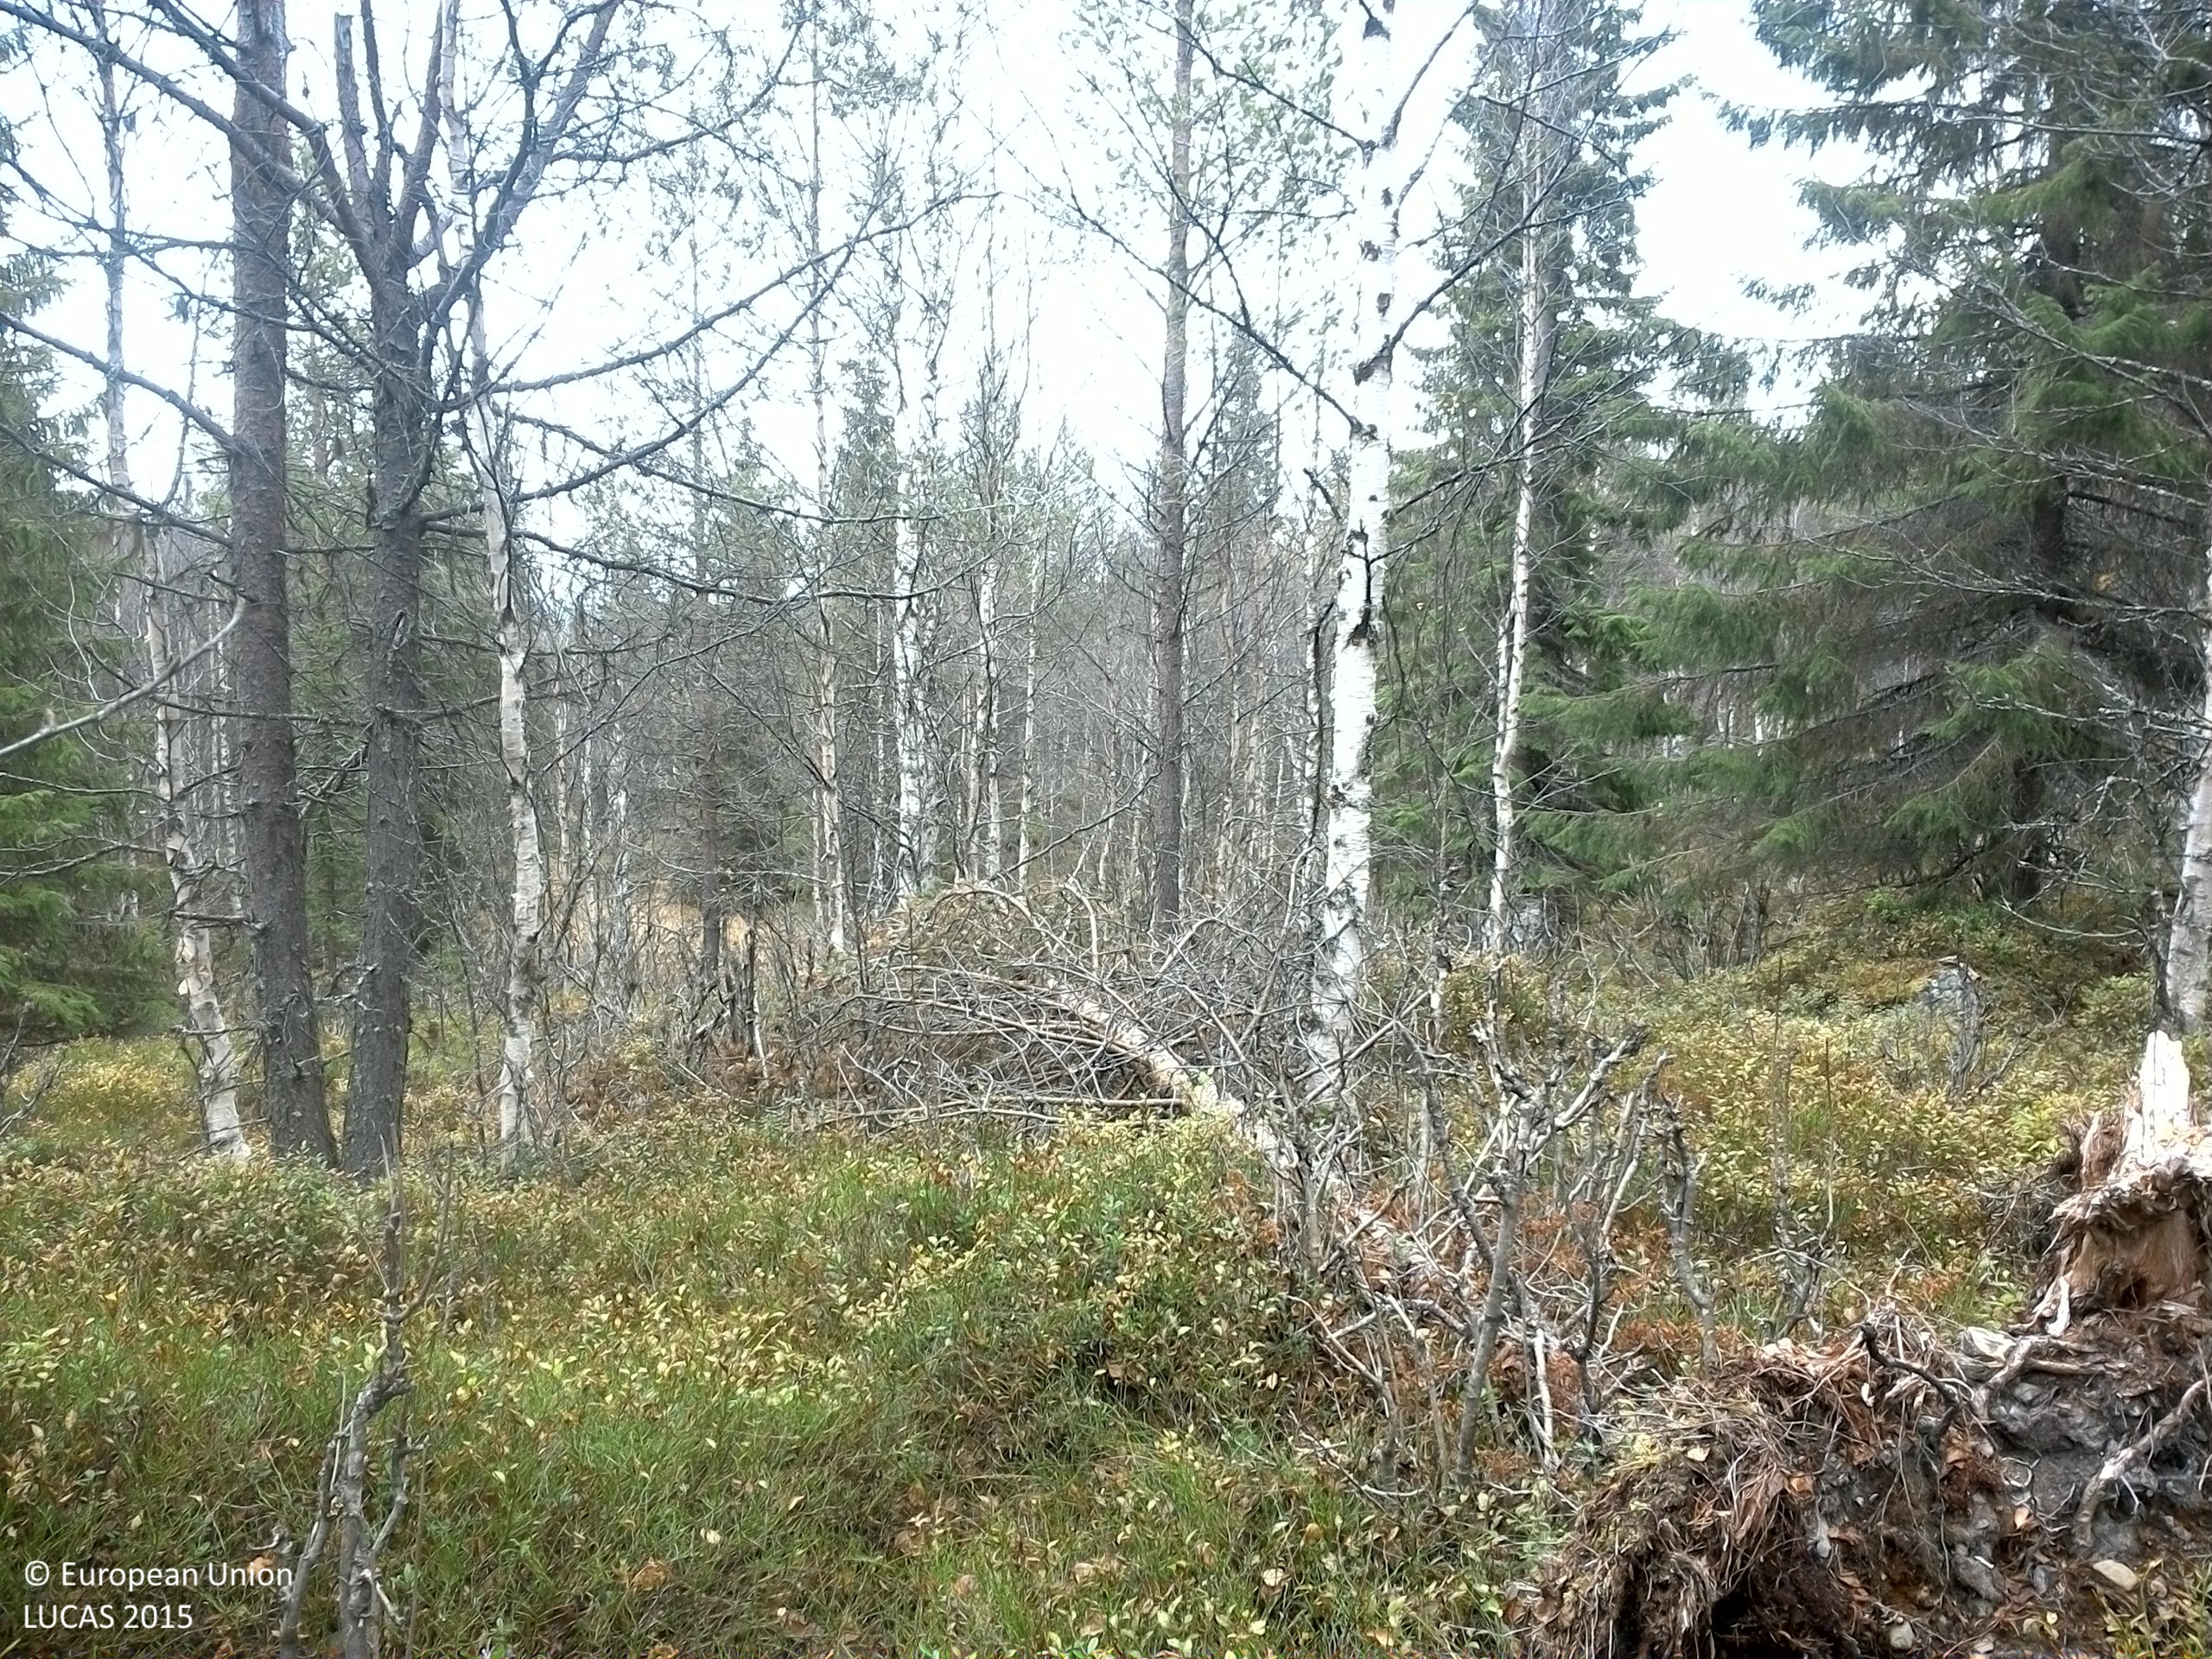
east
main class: Woodland
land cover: Spruce dominated mixed woodland
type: boreal forest
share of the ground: 50 - 75 %
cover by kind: coniferous forest trees 30 %, broadleaved forest trees 25 %, shrubs 20 %, herbaceous plants 15 %, lichens and mosses 10 %
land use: Forestry
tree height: > 5 m
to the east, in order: Spruce dominated mixed woodland; Other mixed woodland; Pine dominated mixed woodland
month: October
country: SE
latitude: 64.3931
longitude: 15.5076
